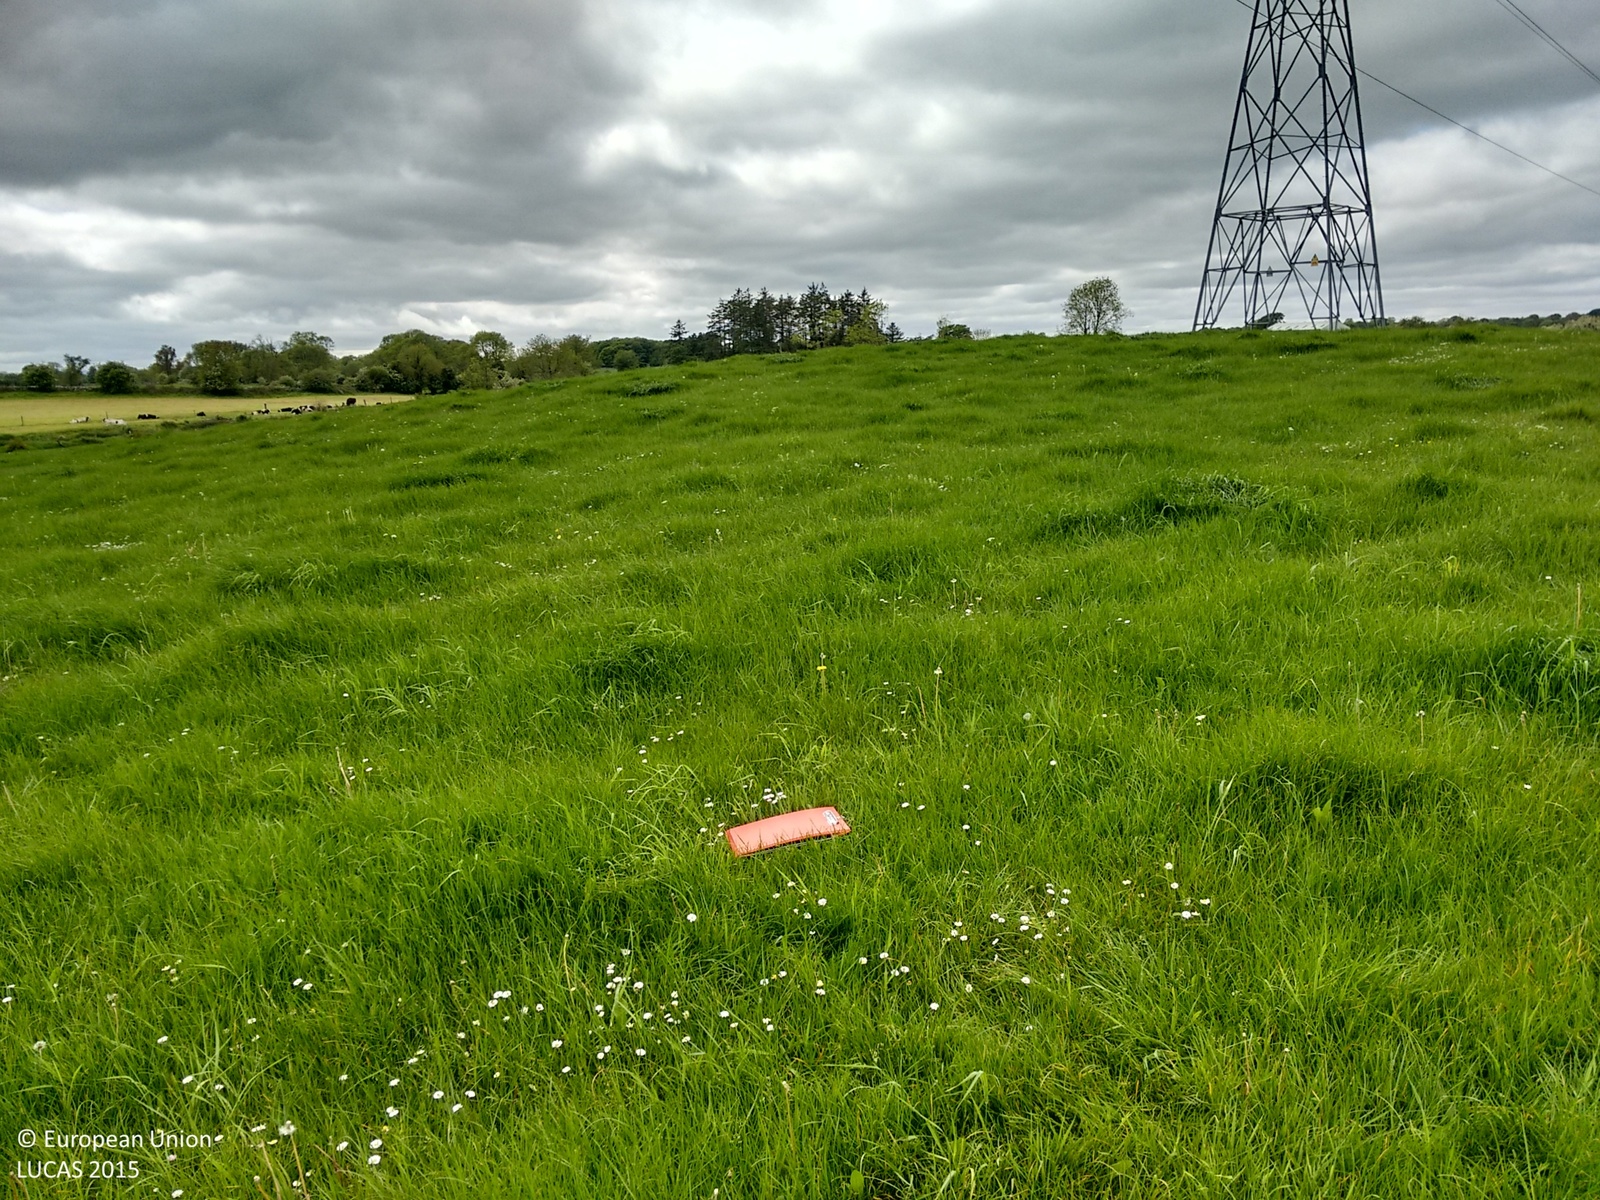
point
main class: Grassland
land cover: Grassland without tree/shrub cover
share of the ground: > 75 %
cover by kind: herbaceous plants 100 %
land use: Agriculture (excluding fallow land and kitchen gardens)
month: May
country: IE
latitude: 53.2594
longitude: -8.6839
